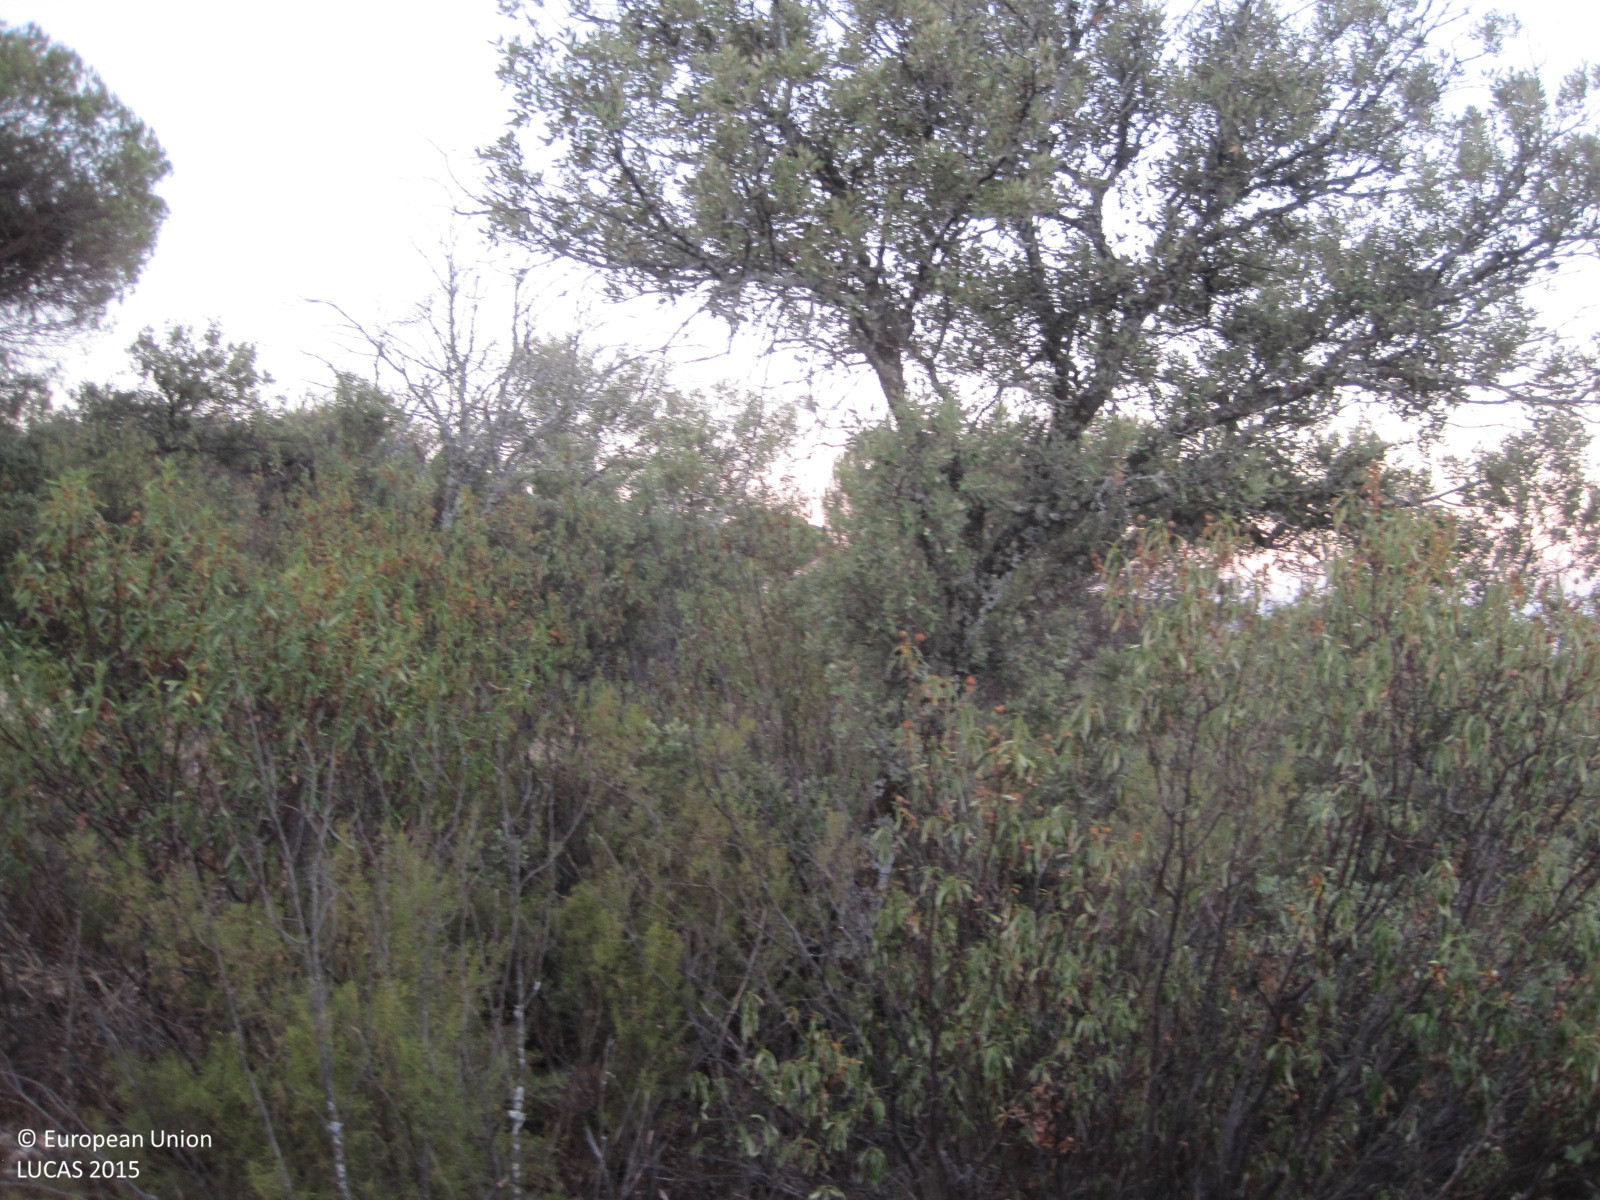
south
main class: Woodland
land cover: Pine dominated mixed woodland
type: coniferous forest of the mediterranean region
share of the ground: > 75 %
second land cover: Shrubland without tree cover
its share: 50 - 75 %
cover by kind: coniferous forest trees 70 %, broadleaved forest trees 30 %
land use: Forestry
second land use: Agriculture (excluding fallow land and kitchen gardens)
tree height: > 5 m
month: July
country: ES
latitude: 40.3047
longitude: -4.3643
